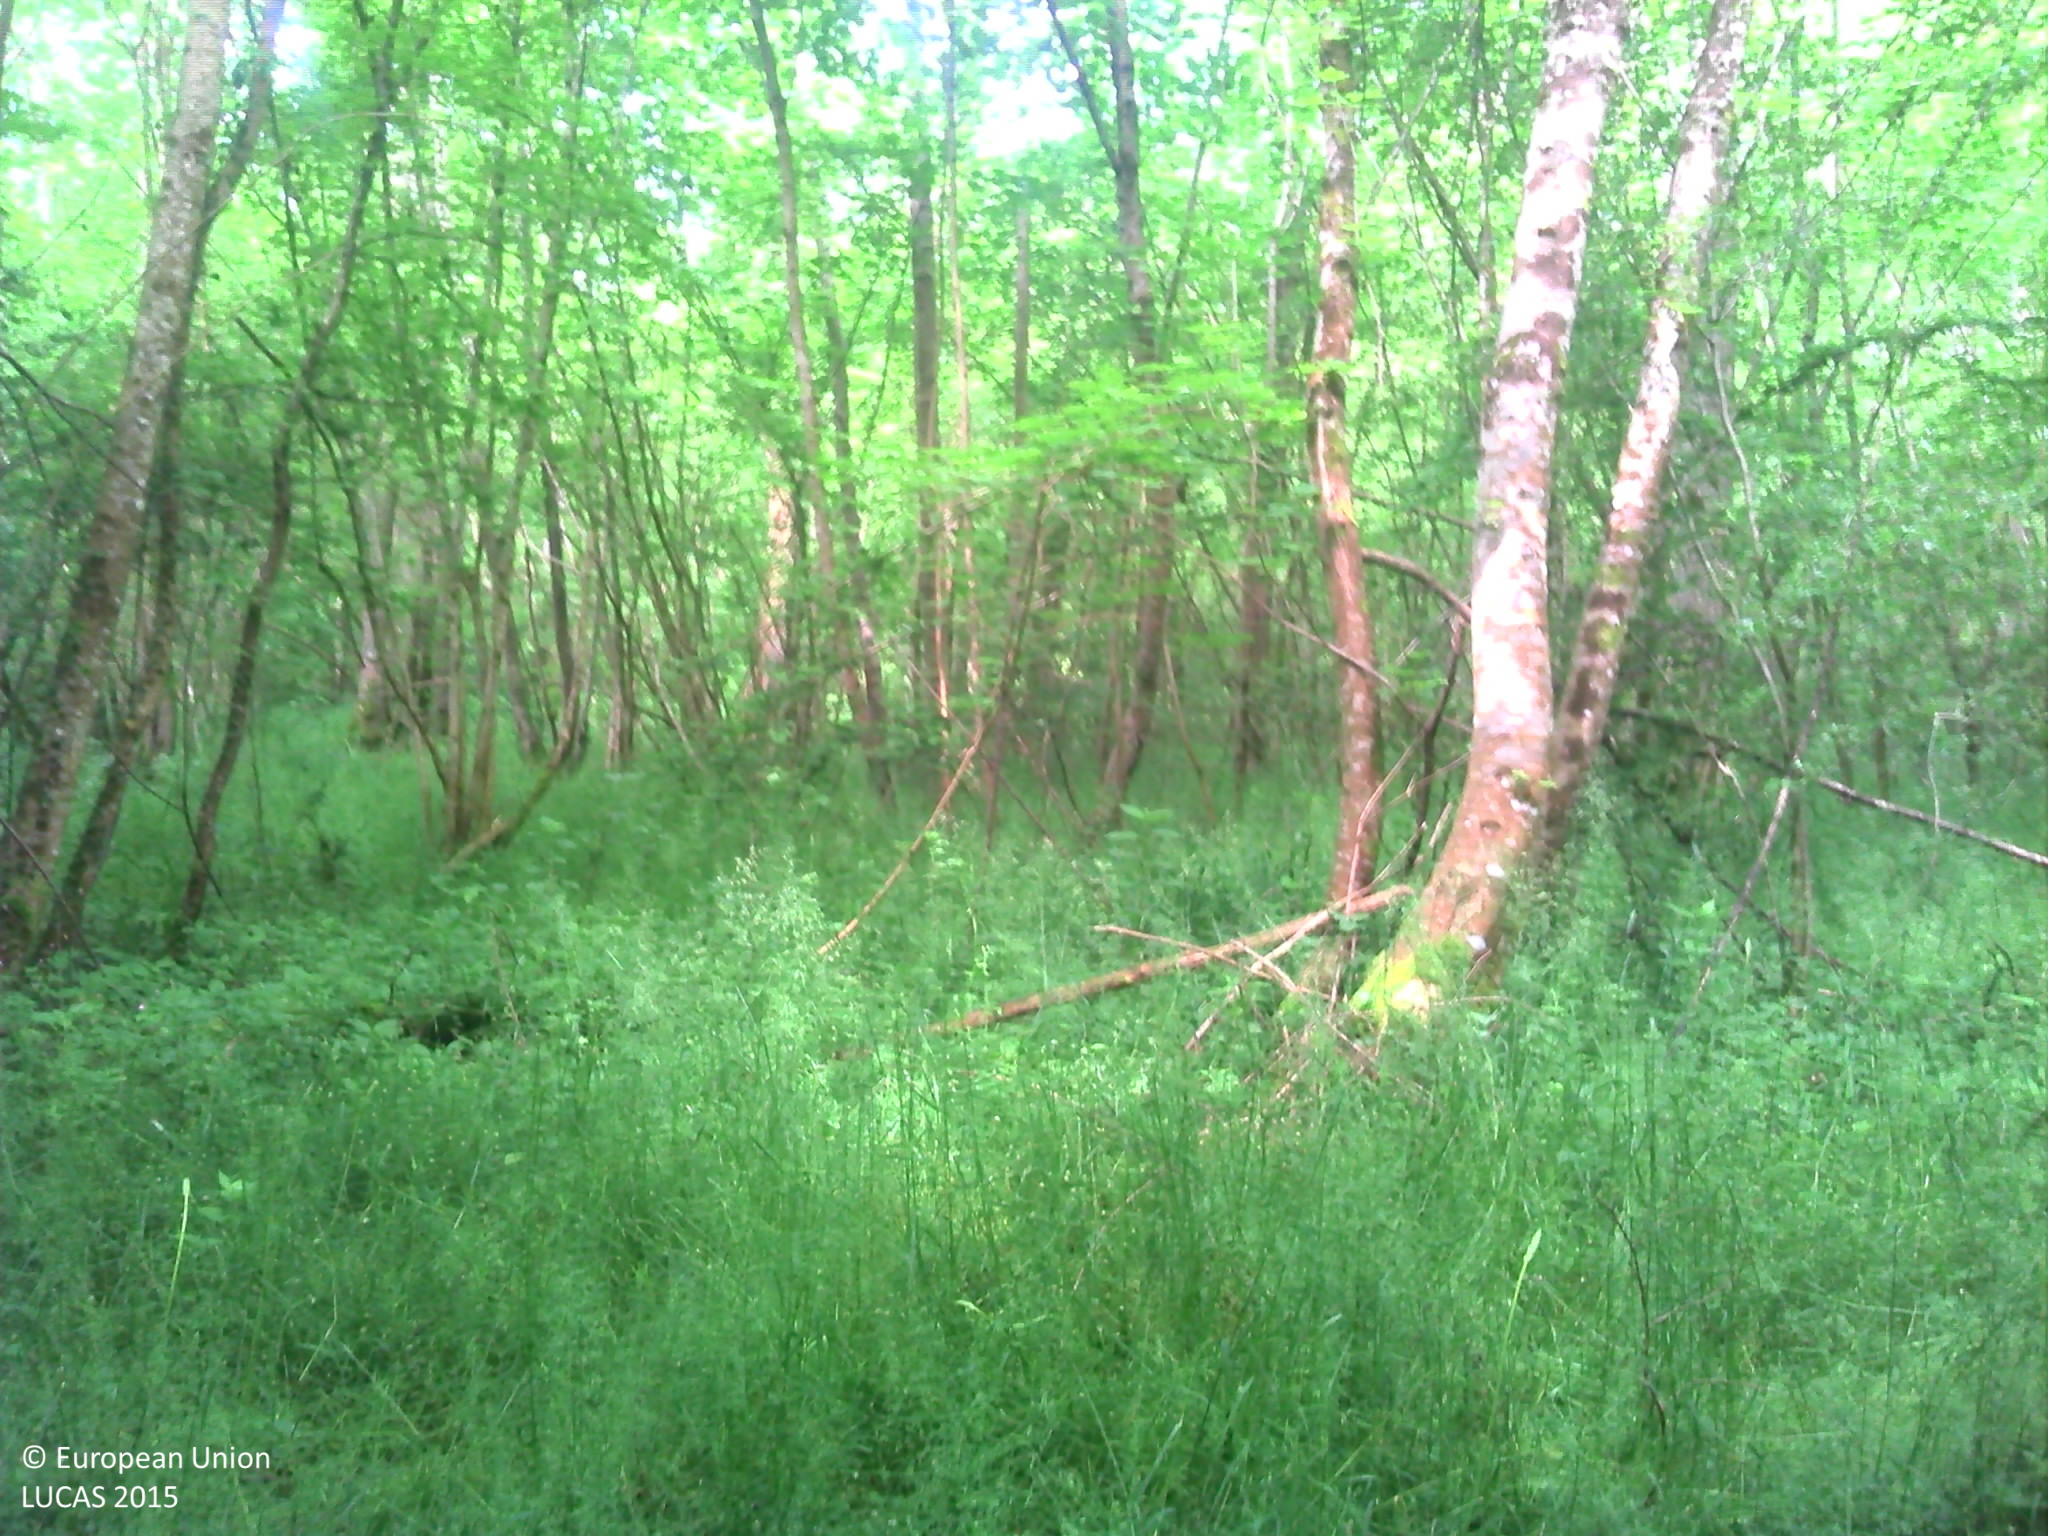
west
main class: Woodland
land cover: Broadleaved woodland
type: mesophytic deciduous forest
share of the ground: > 75 %
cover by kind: broadleaved forest trees 85 %, herbaceous plants 10 %, coniferous forest trees 5 %
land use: Forestry
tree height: > 5 m
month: May
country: FR
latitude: 48.6660
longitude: 4.9334
